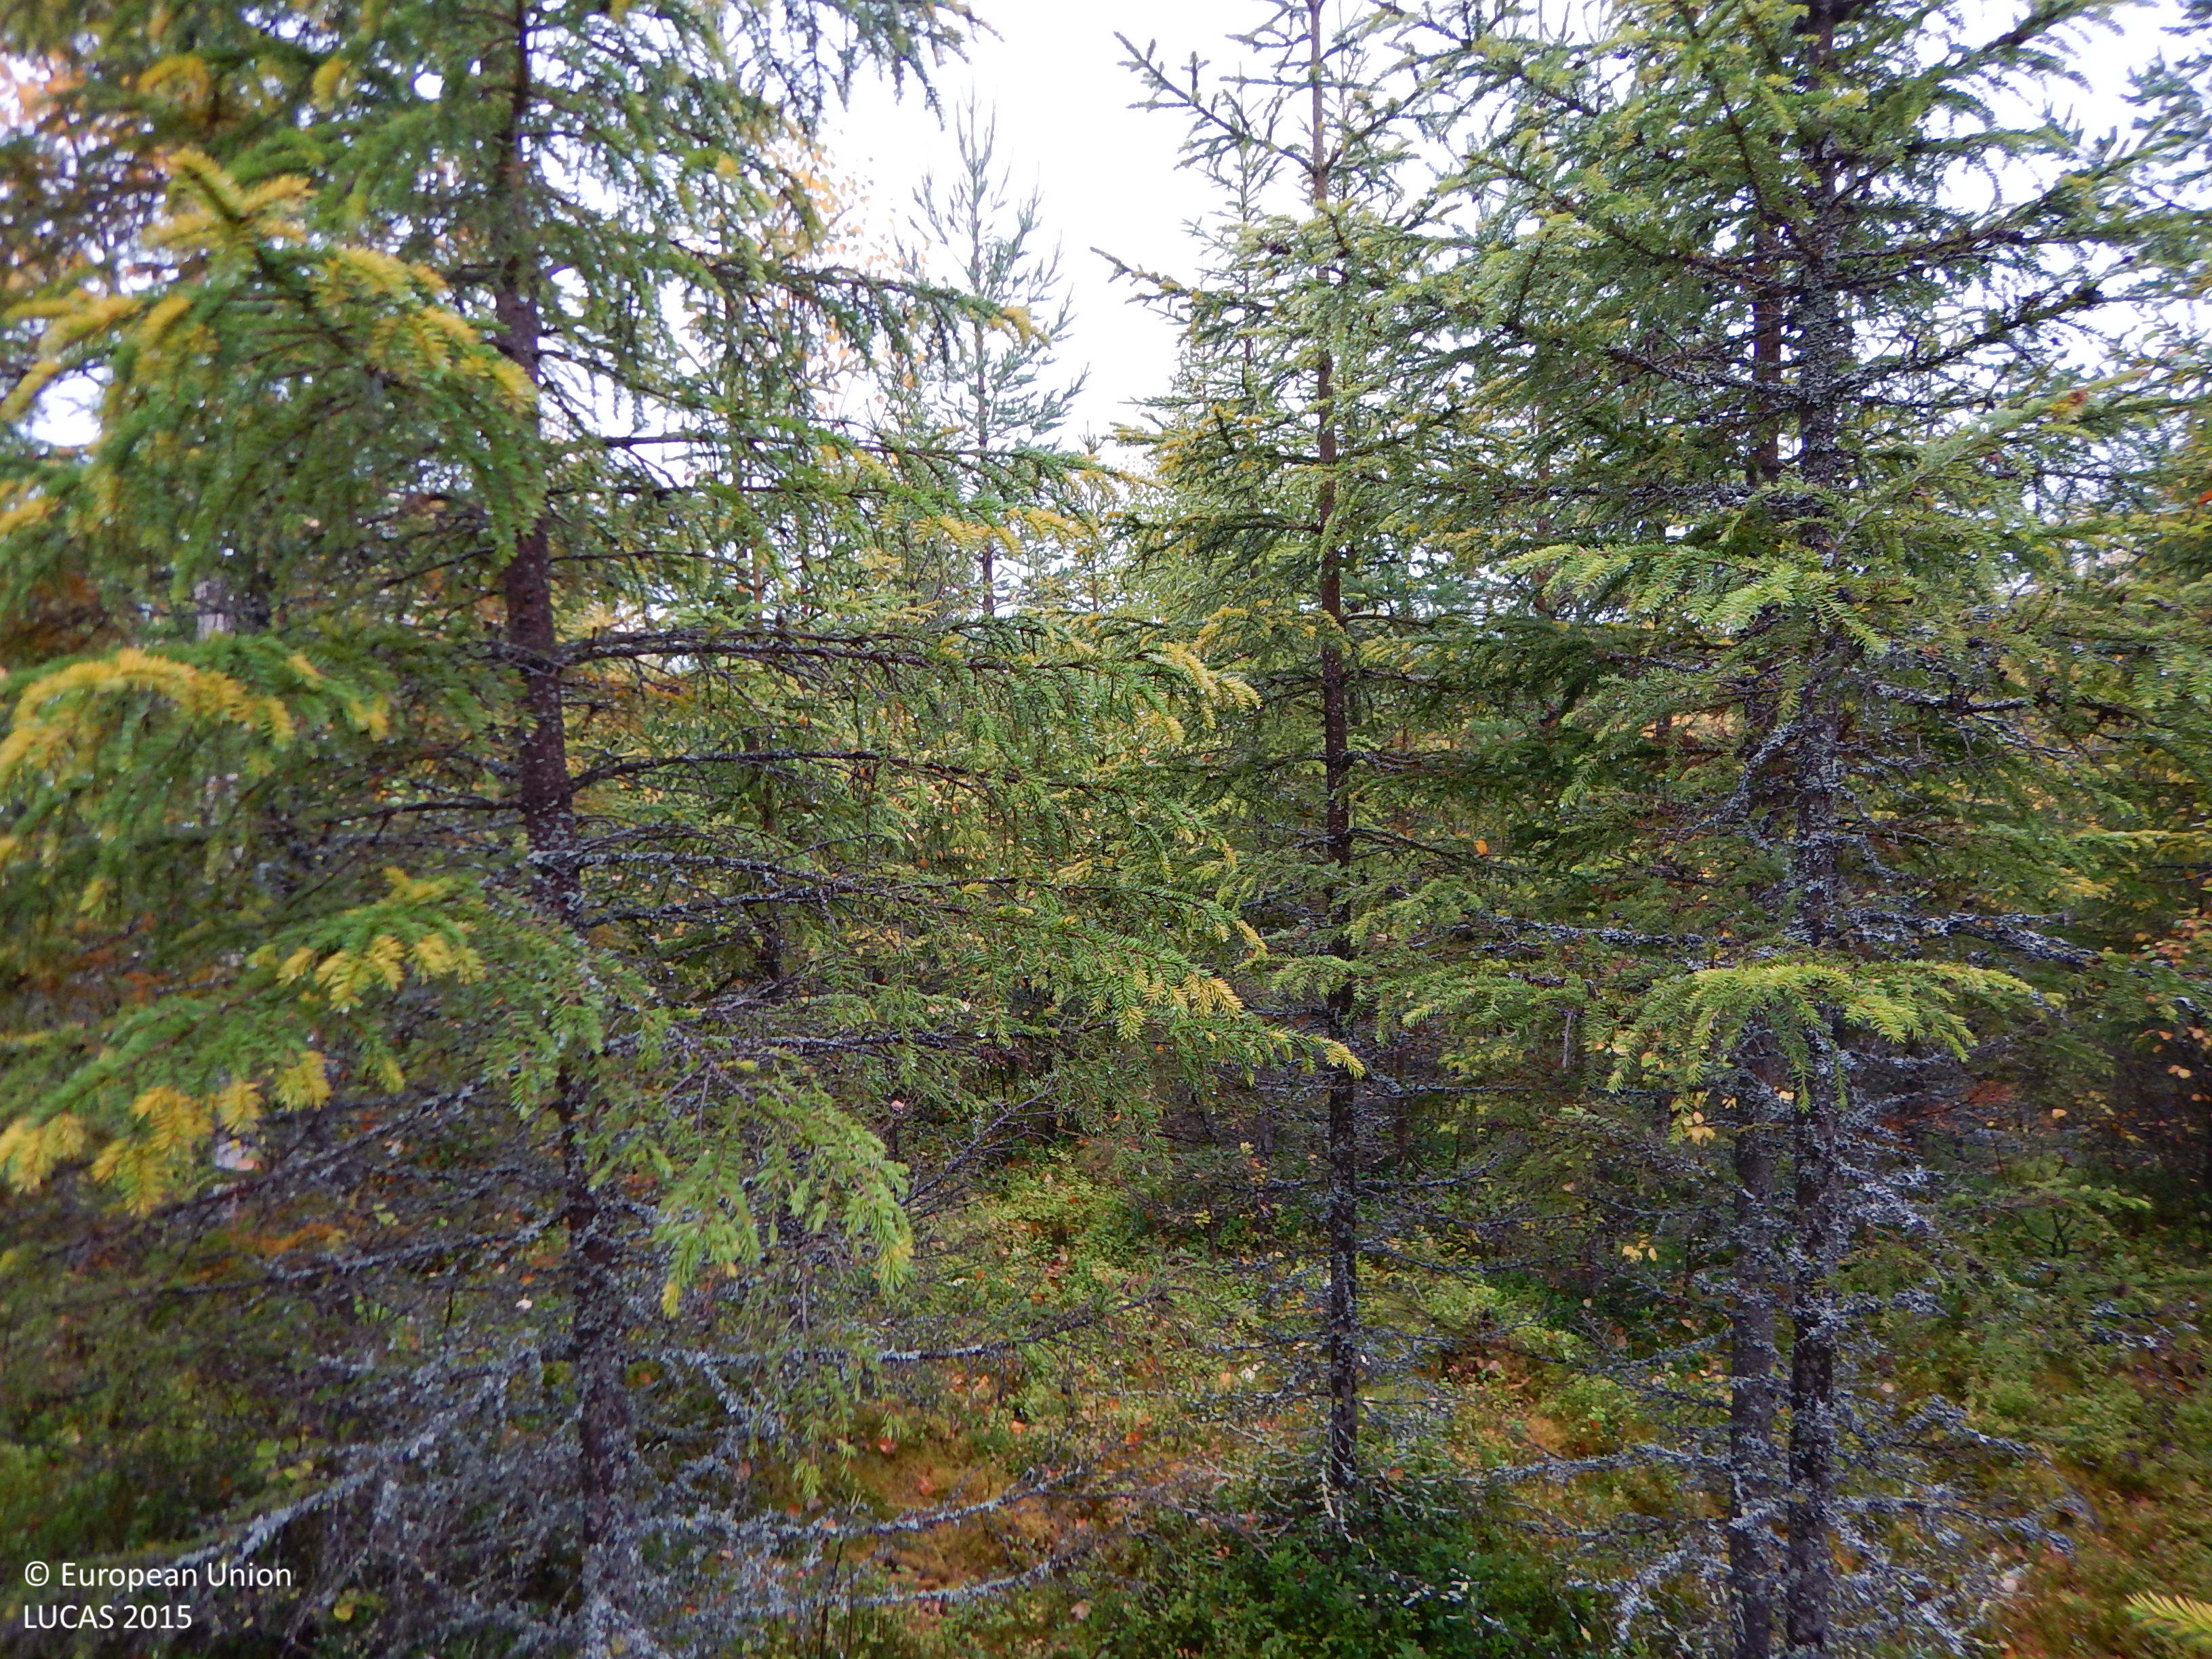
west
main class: Woodland
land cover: Spruce dominated coniferous woodland
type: boreal forest
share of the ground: 50 - 75 %
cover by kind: coniferous forest trees 55 %, lichens and mosses 20 %, shrubs 15 %, broadleaved forest trees 5 %, herbaceous plants 5 %
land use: Forestry
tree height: < 5 m
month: September
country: SE
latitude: 65.0371
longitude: 18.9478
